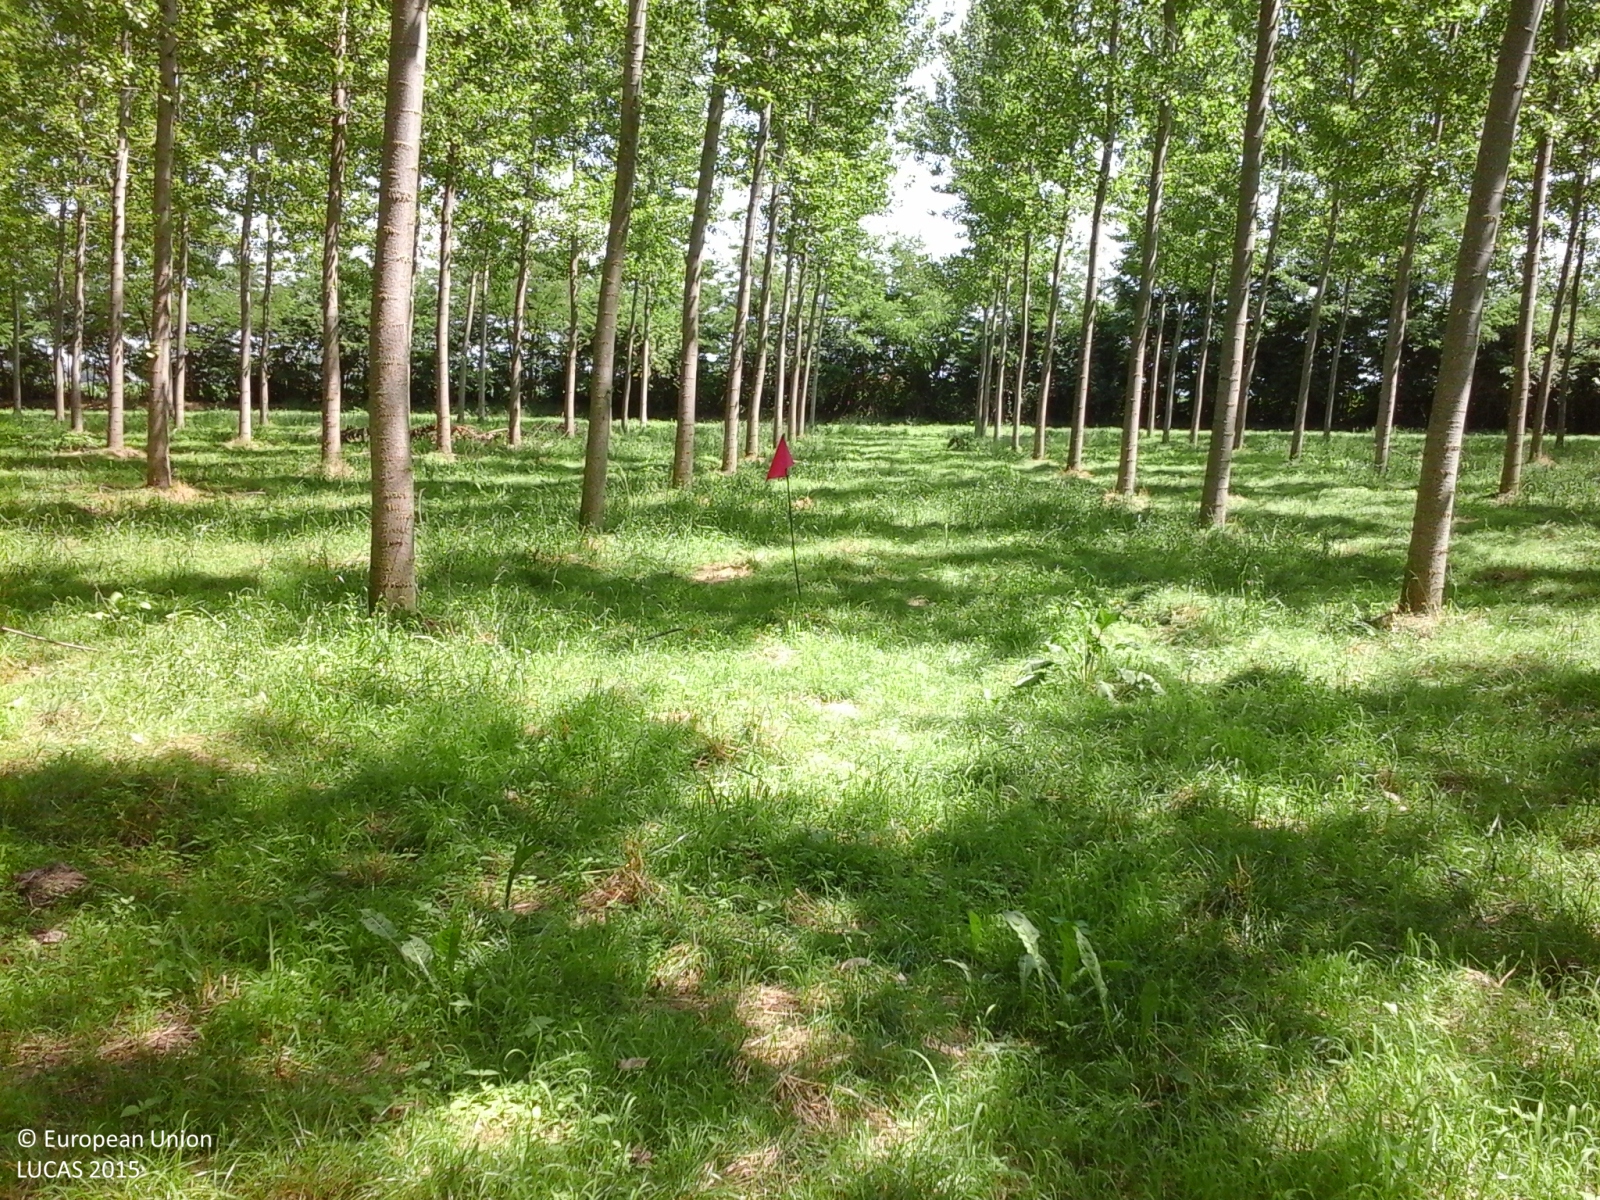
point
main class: Woodland
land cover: Broadleaved woodland
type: non-riverine alder, birch or aspen forest
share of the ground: > 75 %
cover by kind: broadleaved forest trees 100 %
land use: Forestry
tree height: > 5 m
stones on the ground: < 10 %
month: June
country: IT
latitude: 44.8857
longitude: 7.7632
